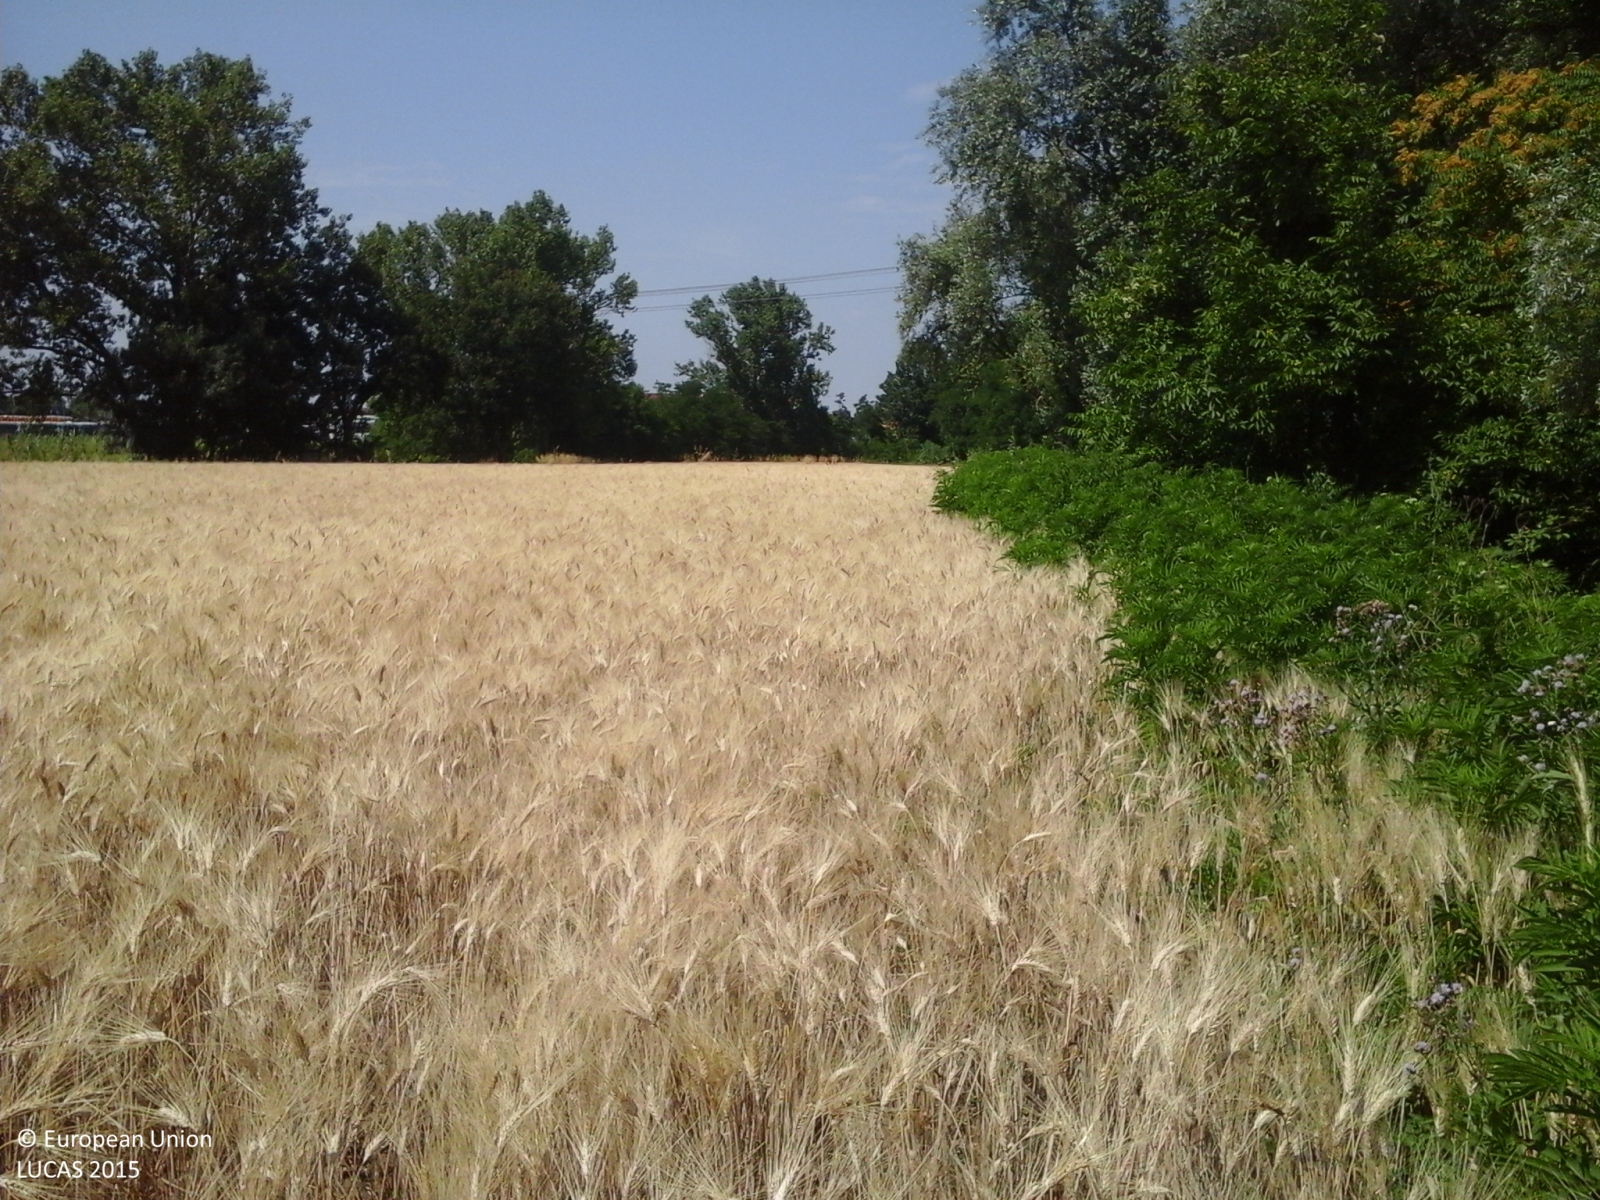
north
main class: Cropland
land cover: Barley
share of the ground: > 75 %
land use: Agriculture (excluding fallow land and kitchen gardens)
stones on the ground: < 10 %
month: June
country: IT
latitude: 44.7468
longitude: 10.3151
